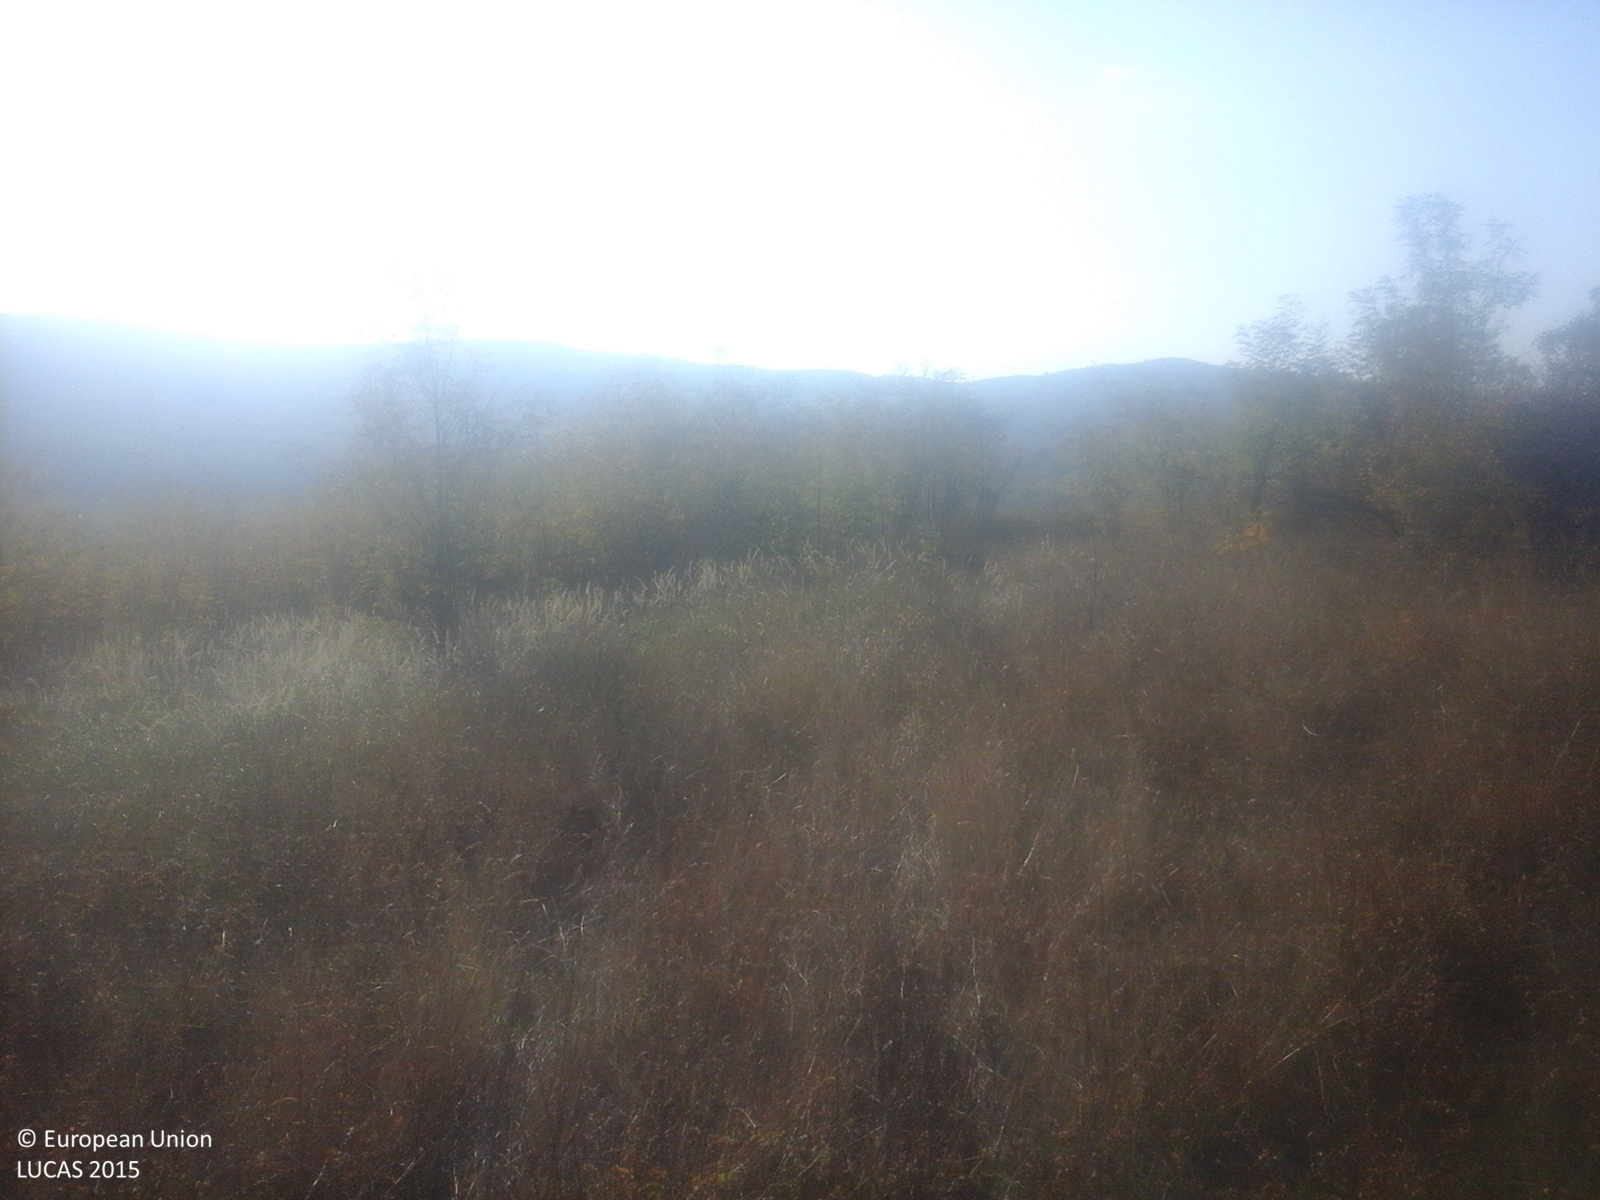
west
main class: Grassland
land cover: Grassland with sparse tree/shrub cover
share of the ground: > 75 %
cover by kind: herbaceous plants 85 %, shrubs 10 %, broadleaved forest trees 5 %
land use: Agriculture (excluding fallow land and kitchen gardens)
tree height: < 5 m
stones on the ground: < 10 %
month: October
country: RO
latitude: 45.3312
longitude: 26.8614
